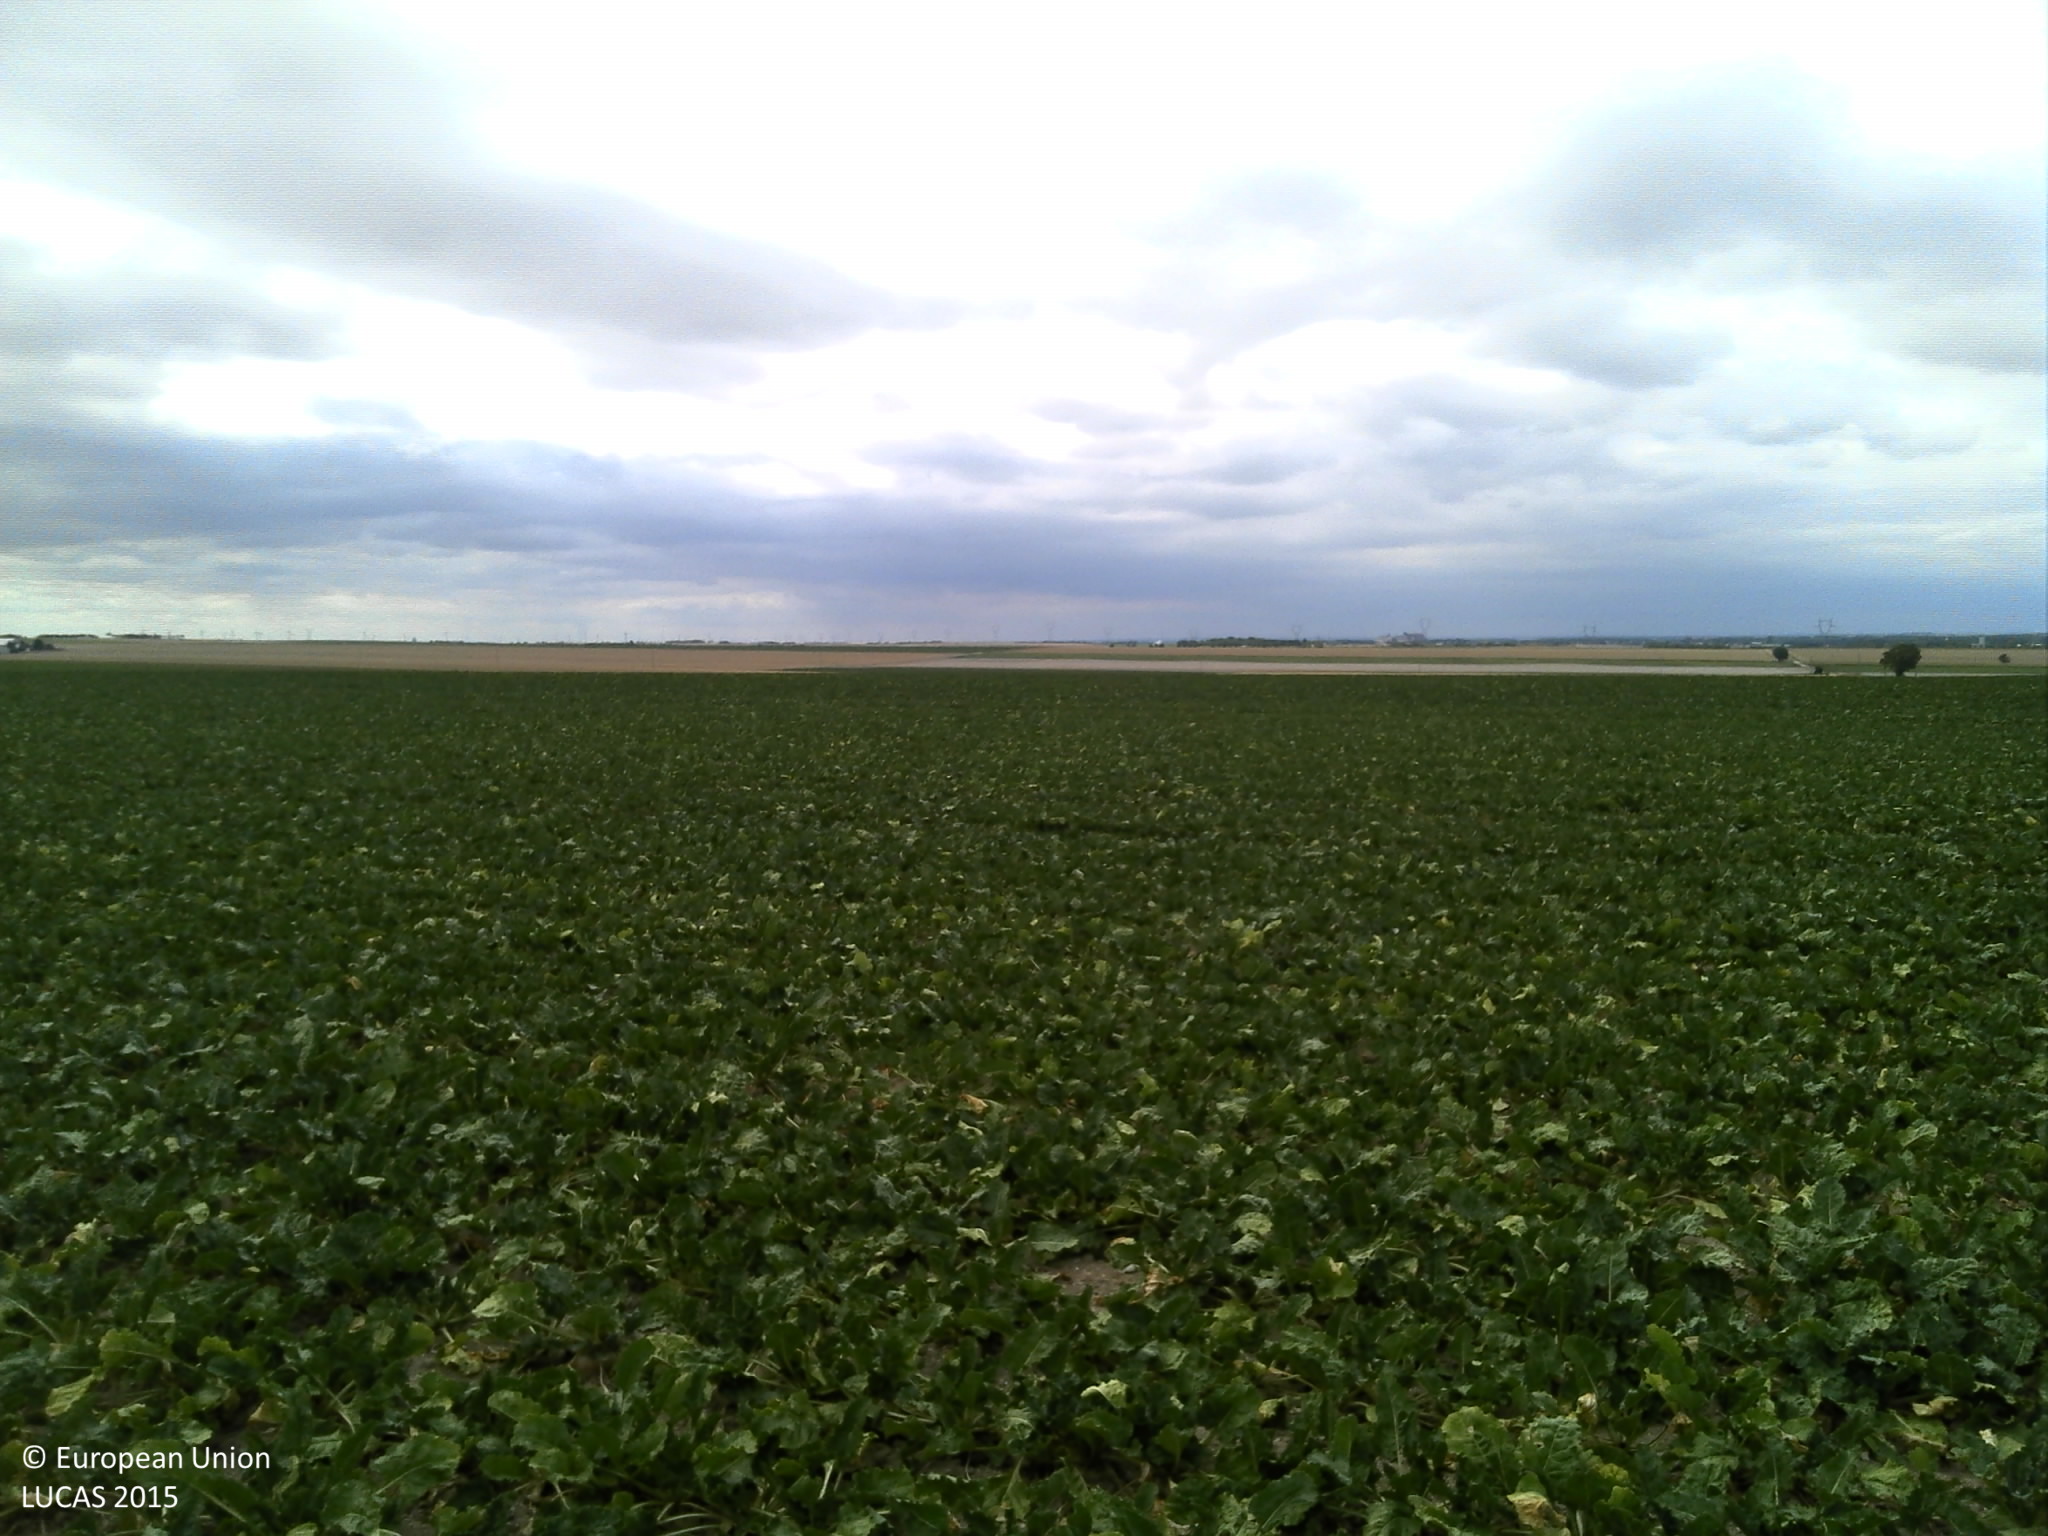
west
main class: Cropland
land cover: Sugar beet
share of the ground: 50 - 75 %
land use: Agriculture (excluding fallow land and kitchen gardens)
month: August
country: FR
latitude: 48.5047
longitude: 4.2170
